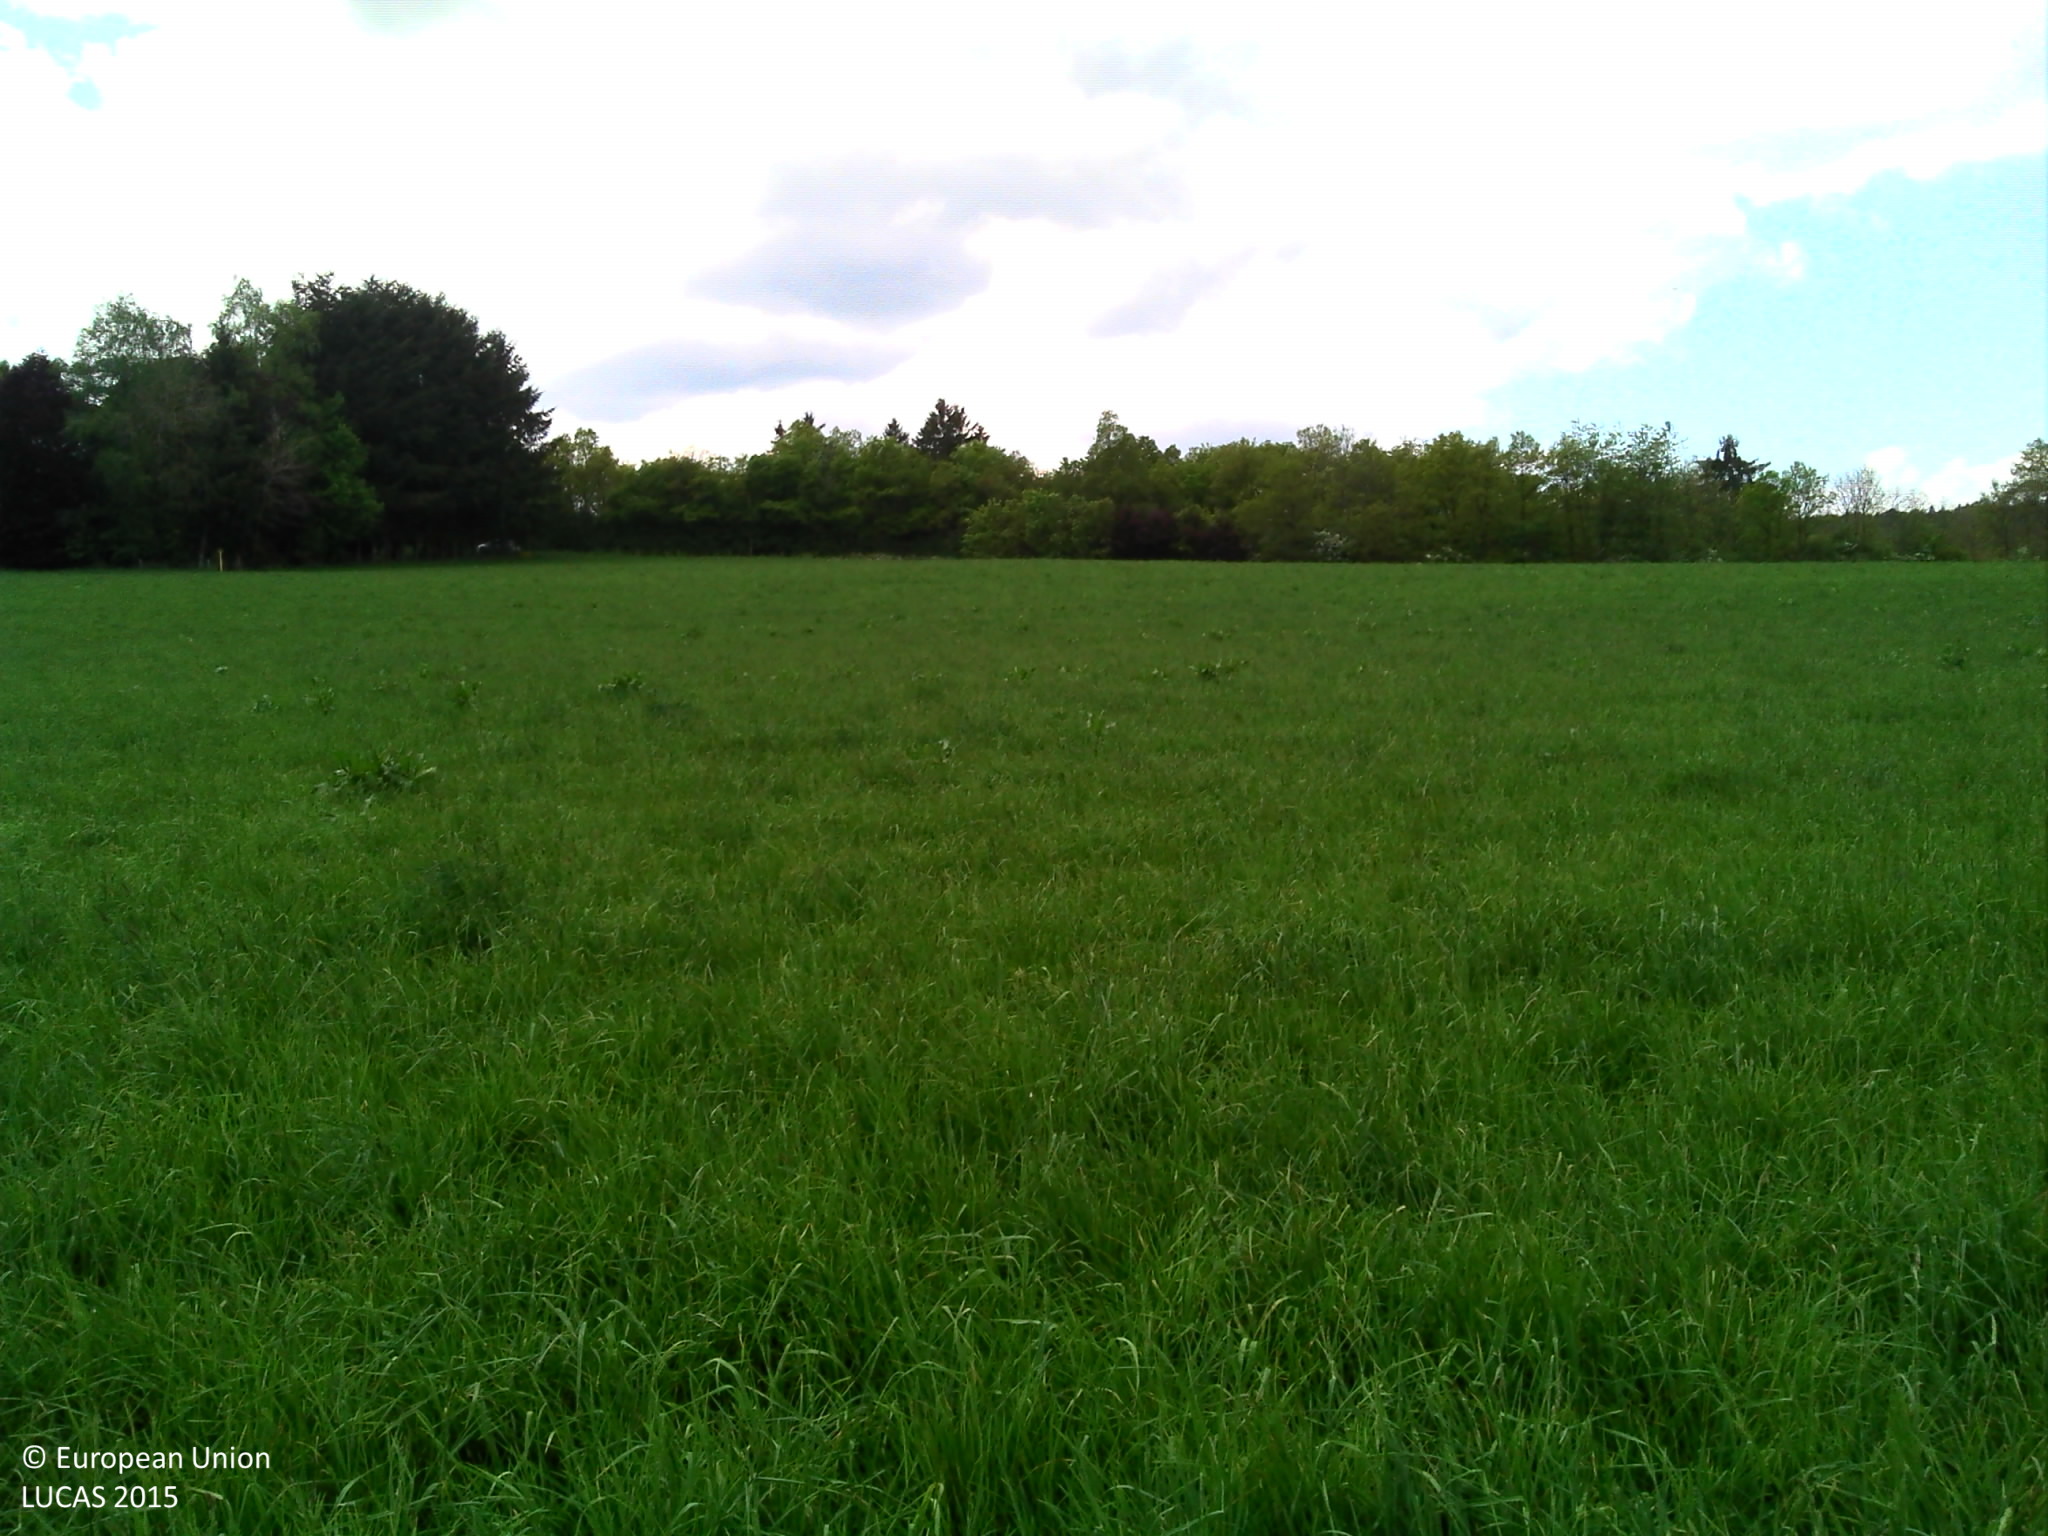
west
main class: Grassland
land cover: Grassland without tree/shrub cover
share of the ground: > 75 %
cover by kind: herbaceous plants 100 %
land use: Agriculture (excluding fallow land and kitchen gardens)
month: May
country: LU
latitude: 49.9660
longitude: 5.8863
